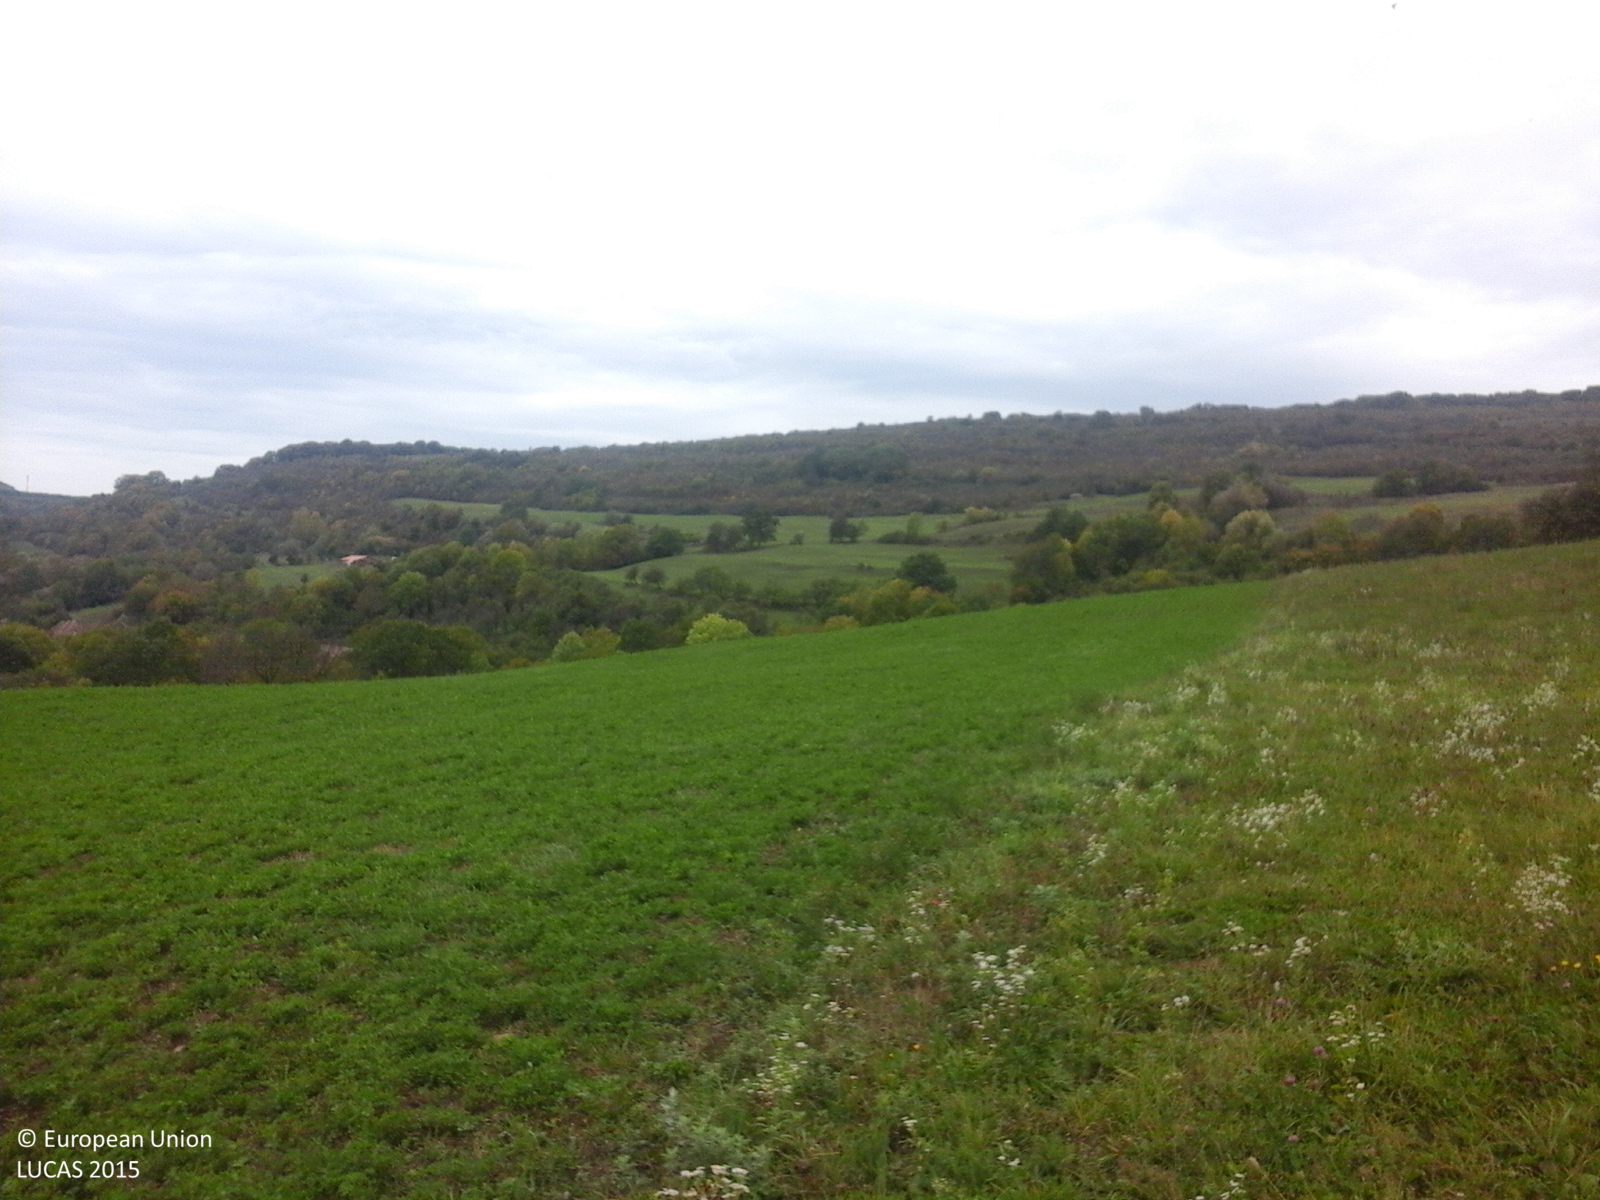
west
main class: Grassland
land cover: Grassland without tree/shrub cover
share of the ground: > 75 %
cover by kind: herbaceous plants 100 %
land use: Agriculture (excluding fallow land and kitchen gardens)
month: October
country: RO
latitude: 46.2658
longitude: 25.1895
